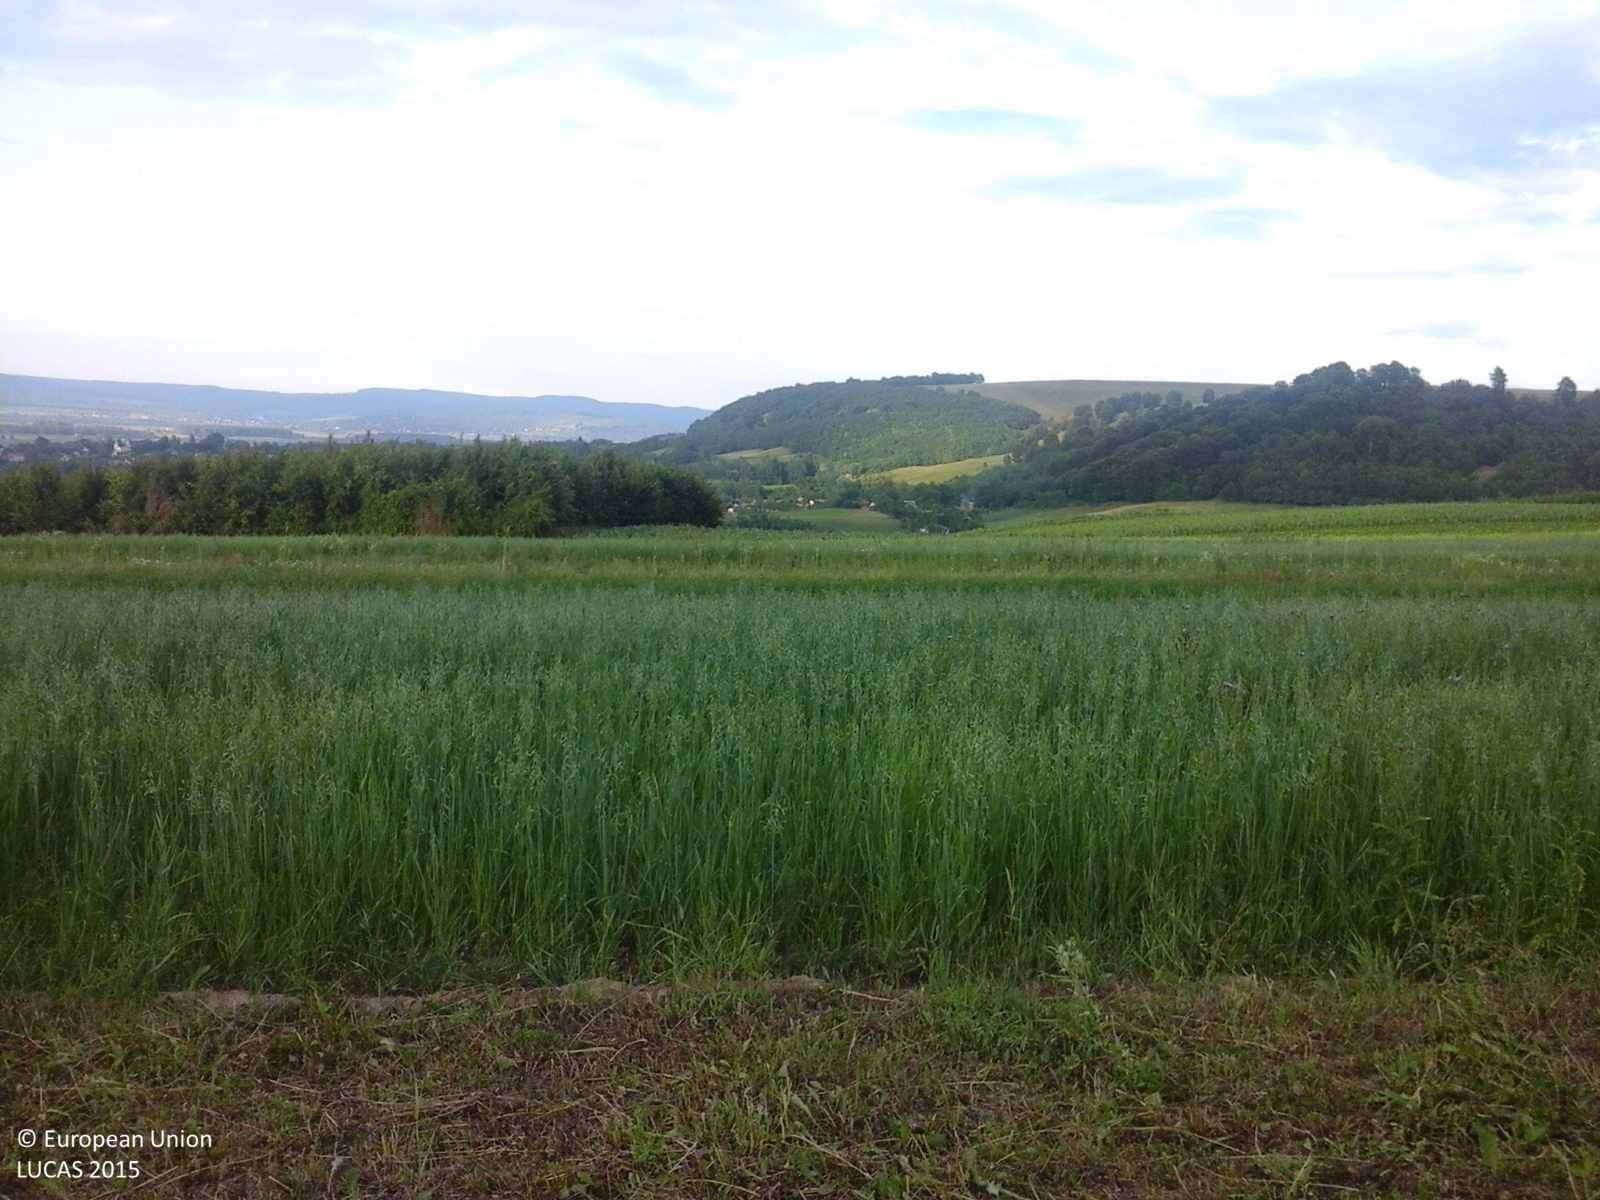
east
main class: Cropland
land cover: Lucerne
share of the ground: > 75 %
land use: Agriculture (excluding fallow land and kitchen gardens)
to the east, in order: Lucerne; Oats; Lucerne; Oats; Lucerne; Oats; Maize; Grass margins; Maize; Lucerne
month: June
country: RO
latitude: 47.4822
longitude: 26.5048
